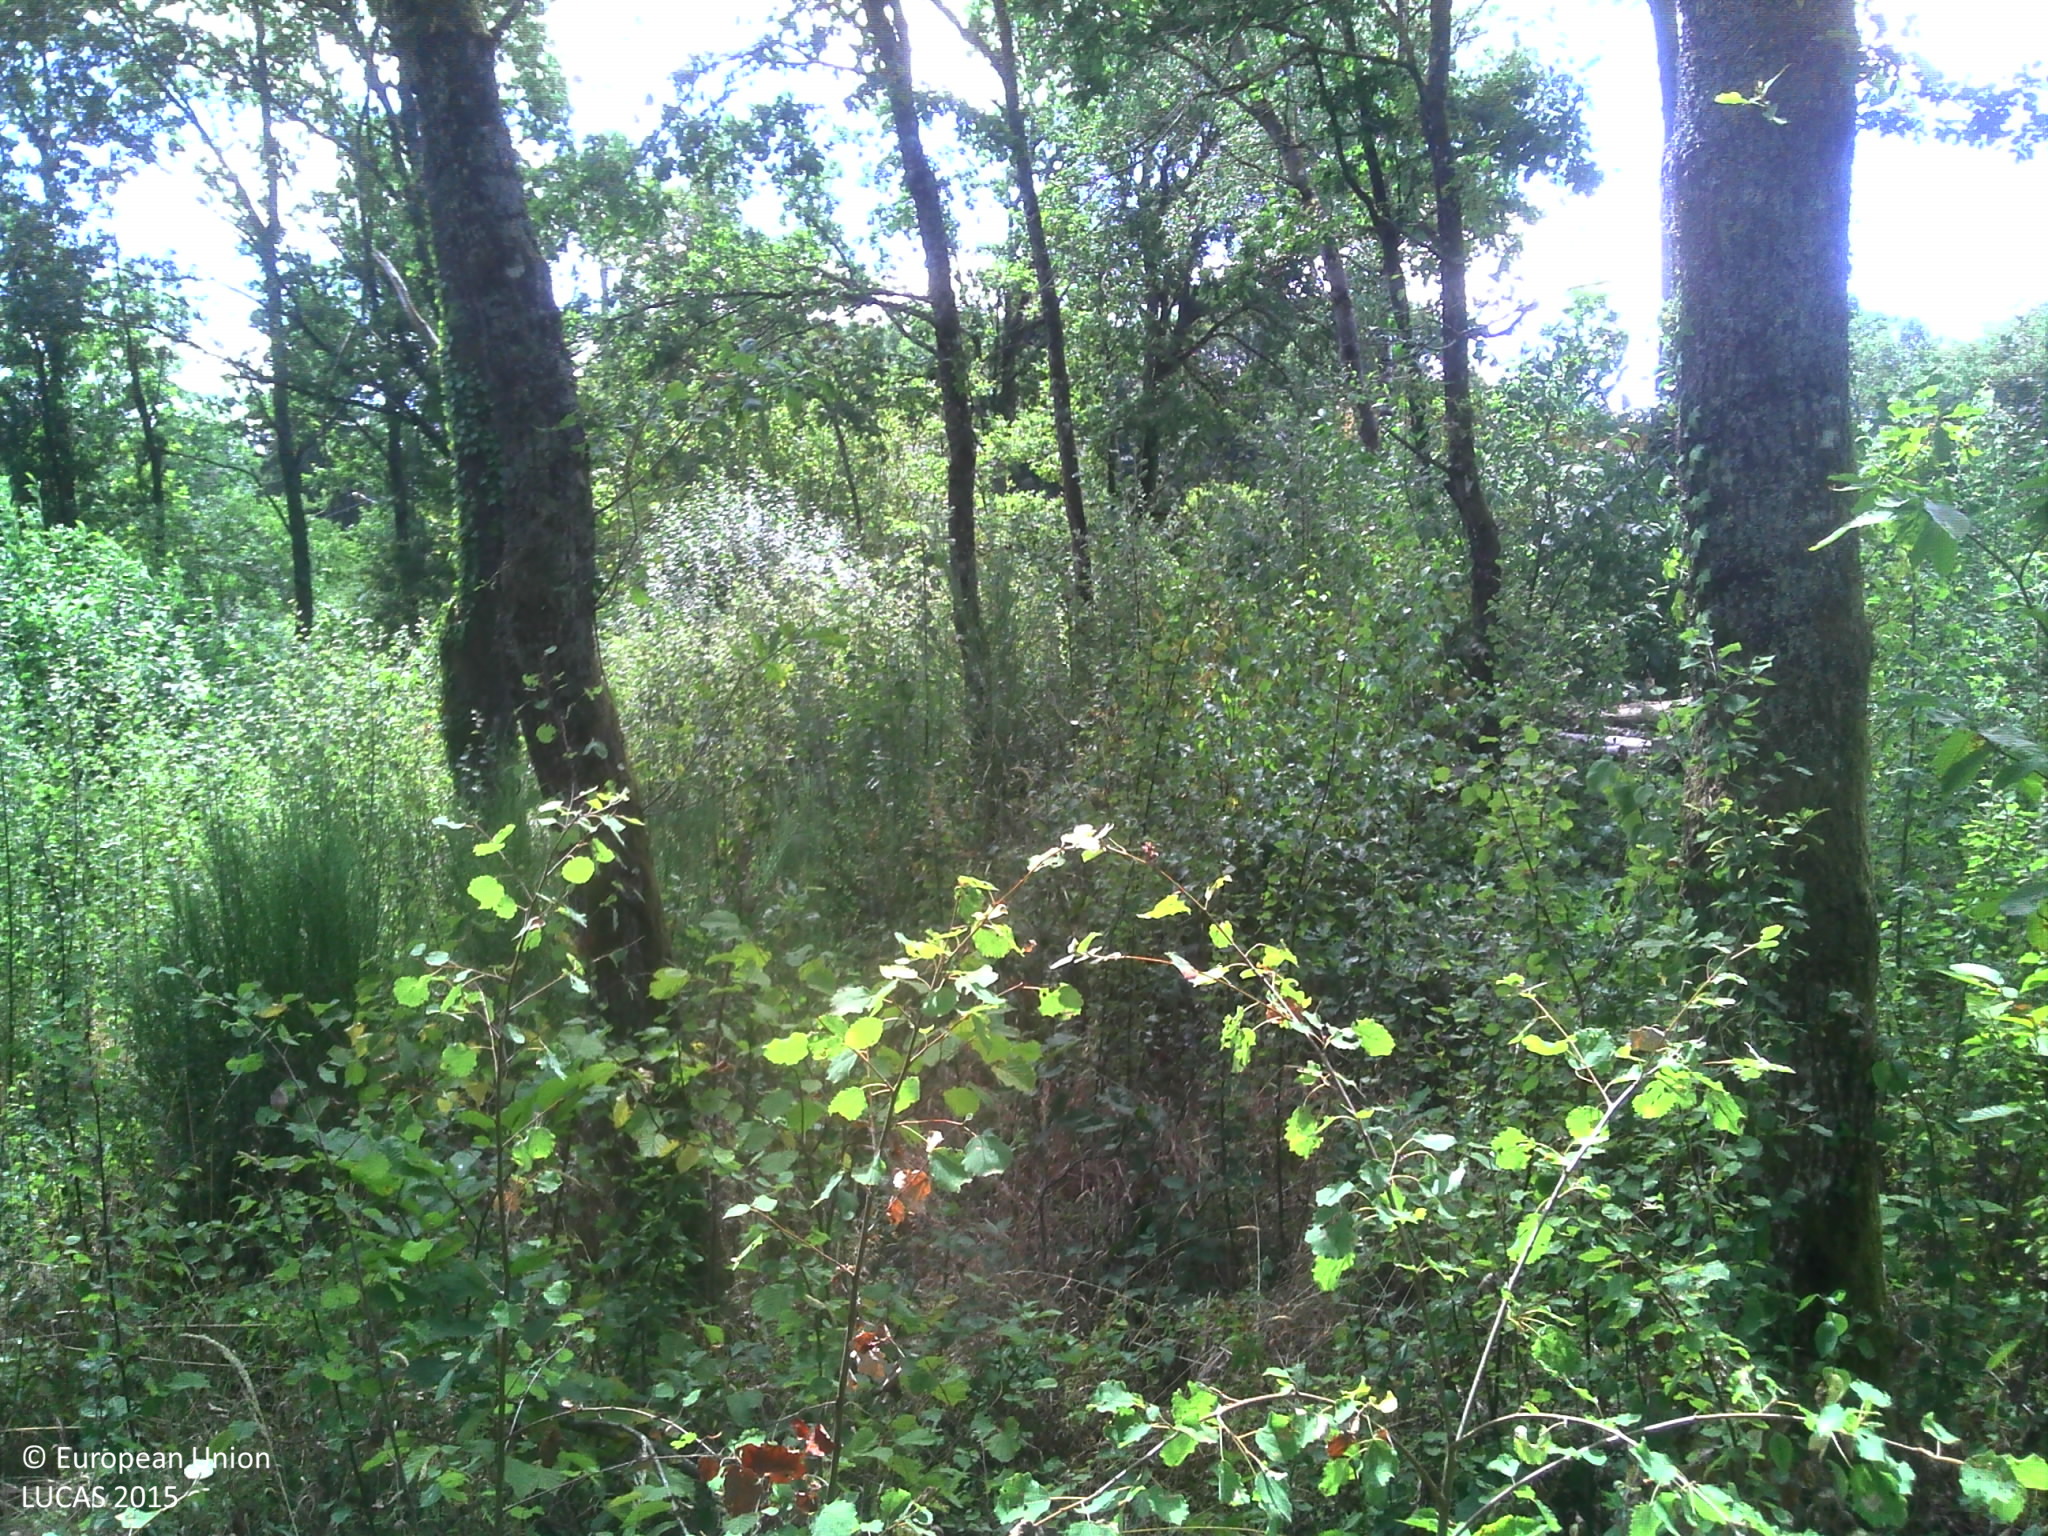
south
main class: Woodland
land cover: Broadleaved woodland
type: acidophilous oak and oak-birch forest
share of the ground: > 75 %
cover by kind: broadleaved forest trees 70 %, herbaceous plants 30 %
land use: Forestry
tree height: > 5 m
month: July
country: FR
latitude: 46.8391
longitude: 4.4541
